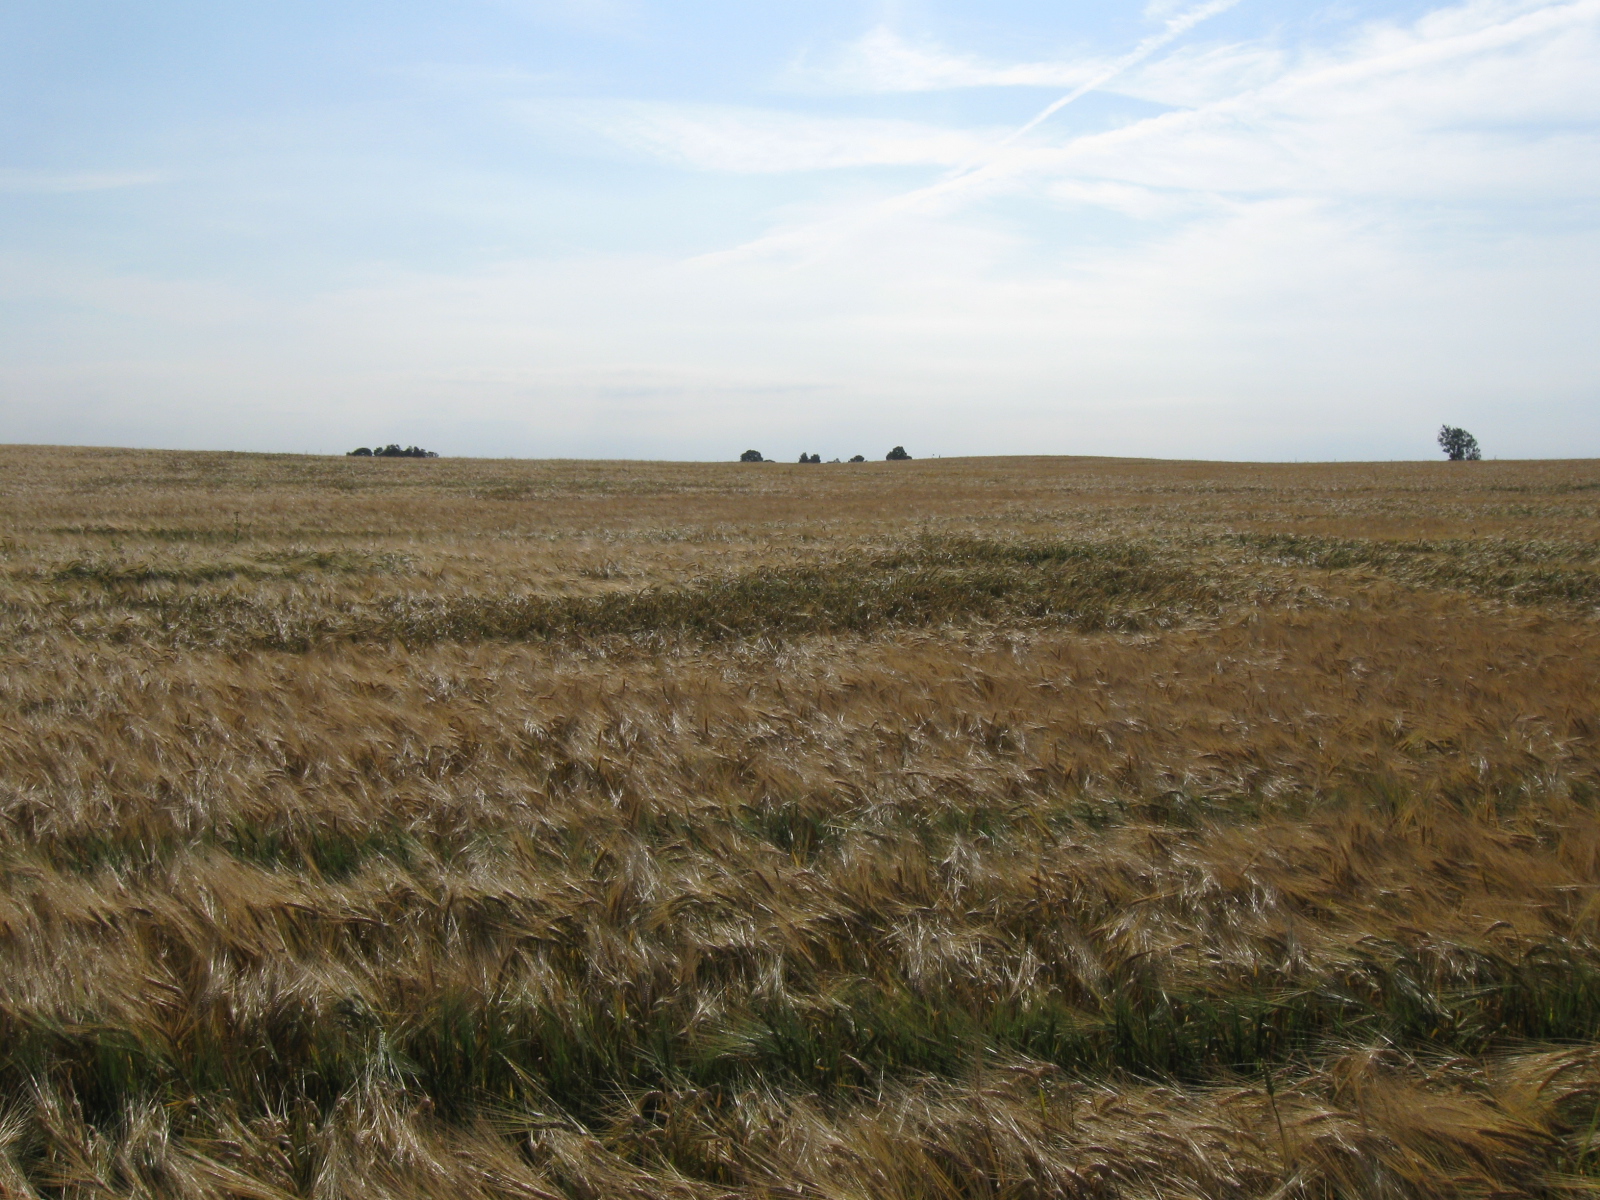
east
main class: Cropland
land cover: Barley
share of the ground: > 75 %
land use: Agriculture (excluding fallow land and kitchen gardens)
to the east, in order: Barley
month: July
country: LT
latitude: 54.4880
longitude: 23.4650
